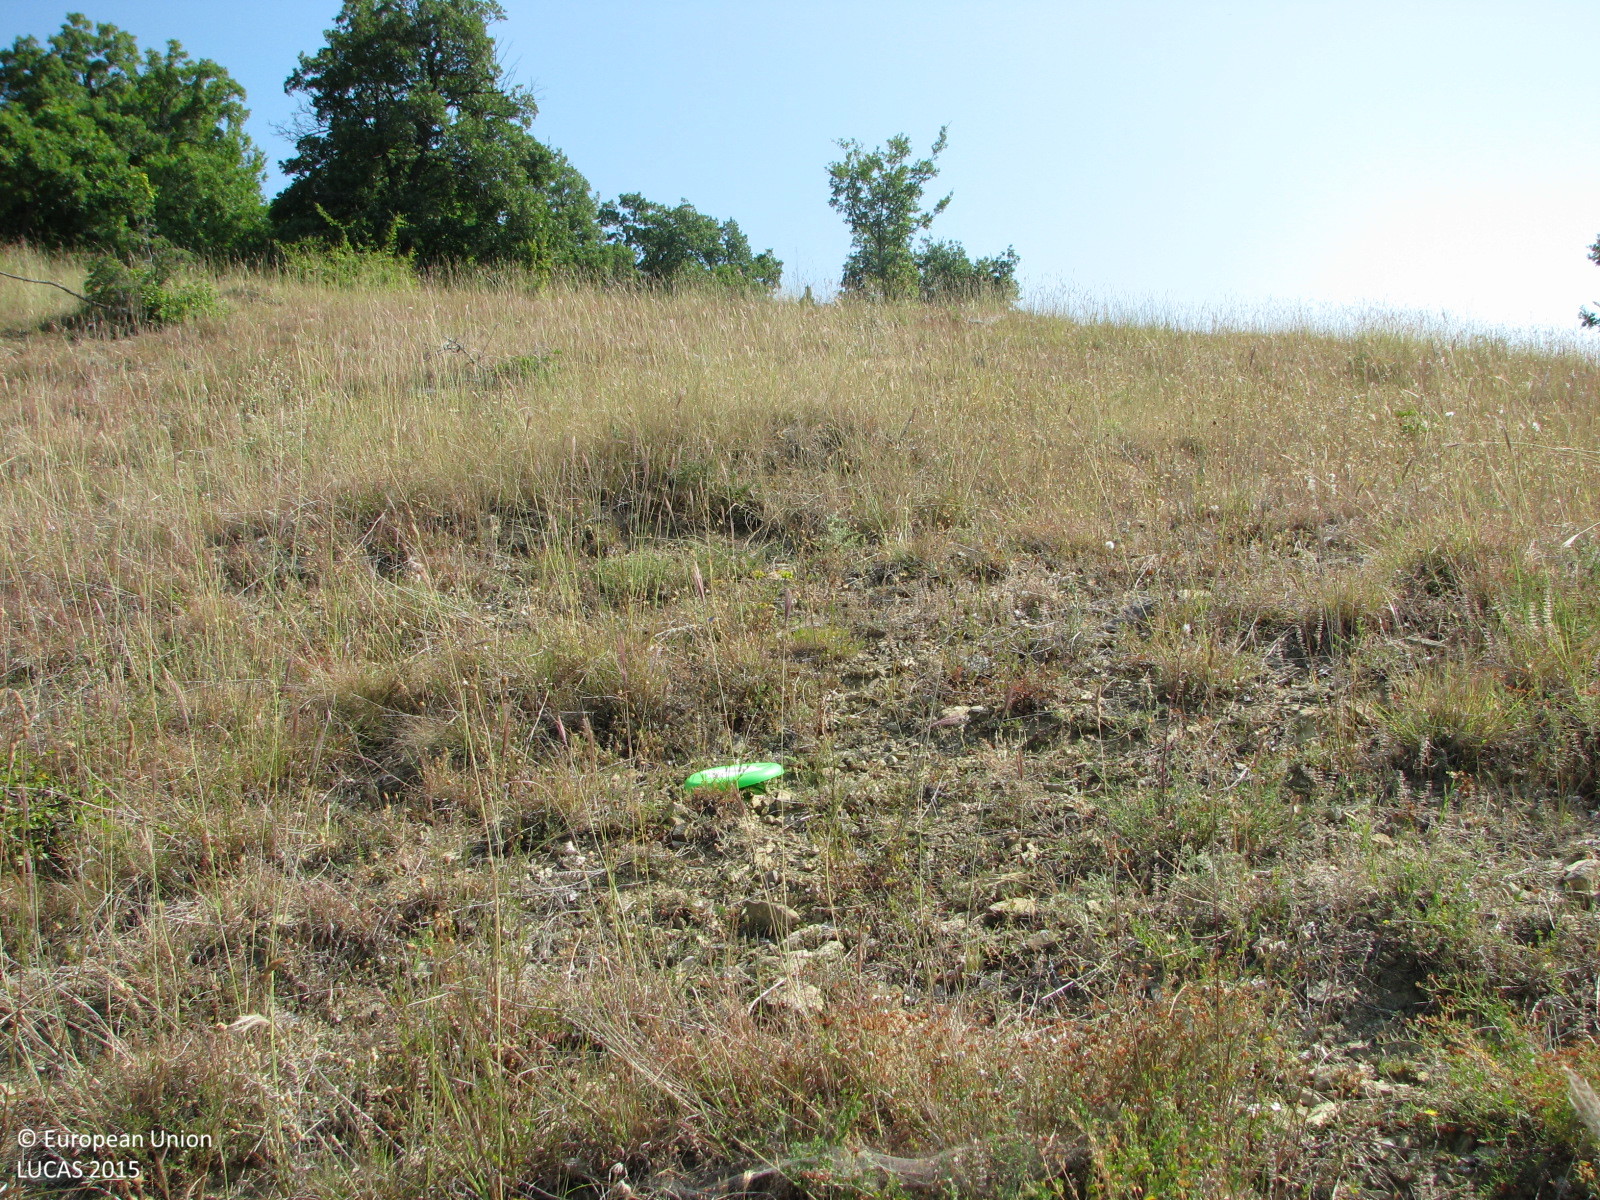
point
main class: Grassland
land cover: Grassland with sparse tree/shrub cover
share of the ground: > 75 %
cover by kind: herbaceous plants 90 %, broadleaved forest trees 5 %, shrubs 5 %
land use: Agriculture (excluding fallow land and kitchen gardens)
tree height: > 5 m
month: July
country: BG
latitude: 42.6741
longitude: 26.1321
